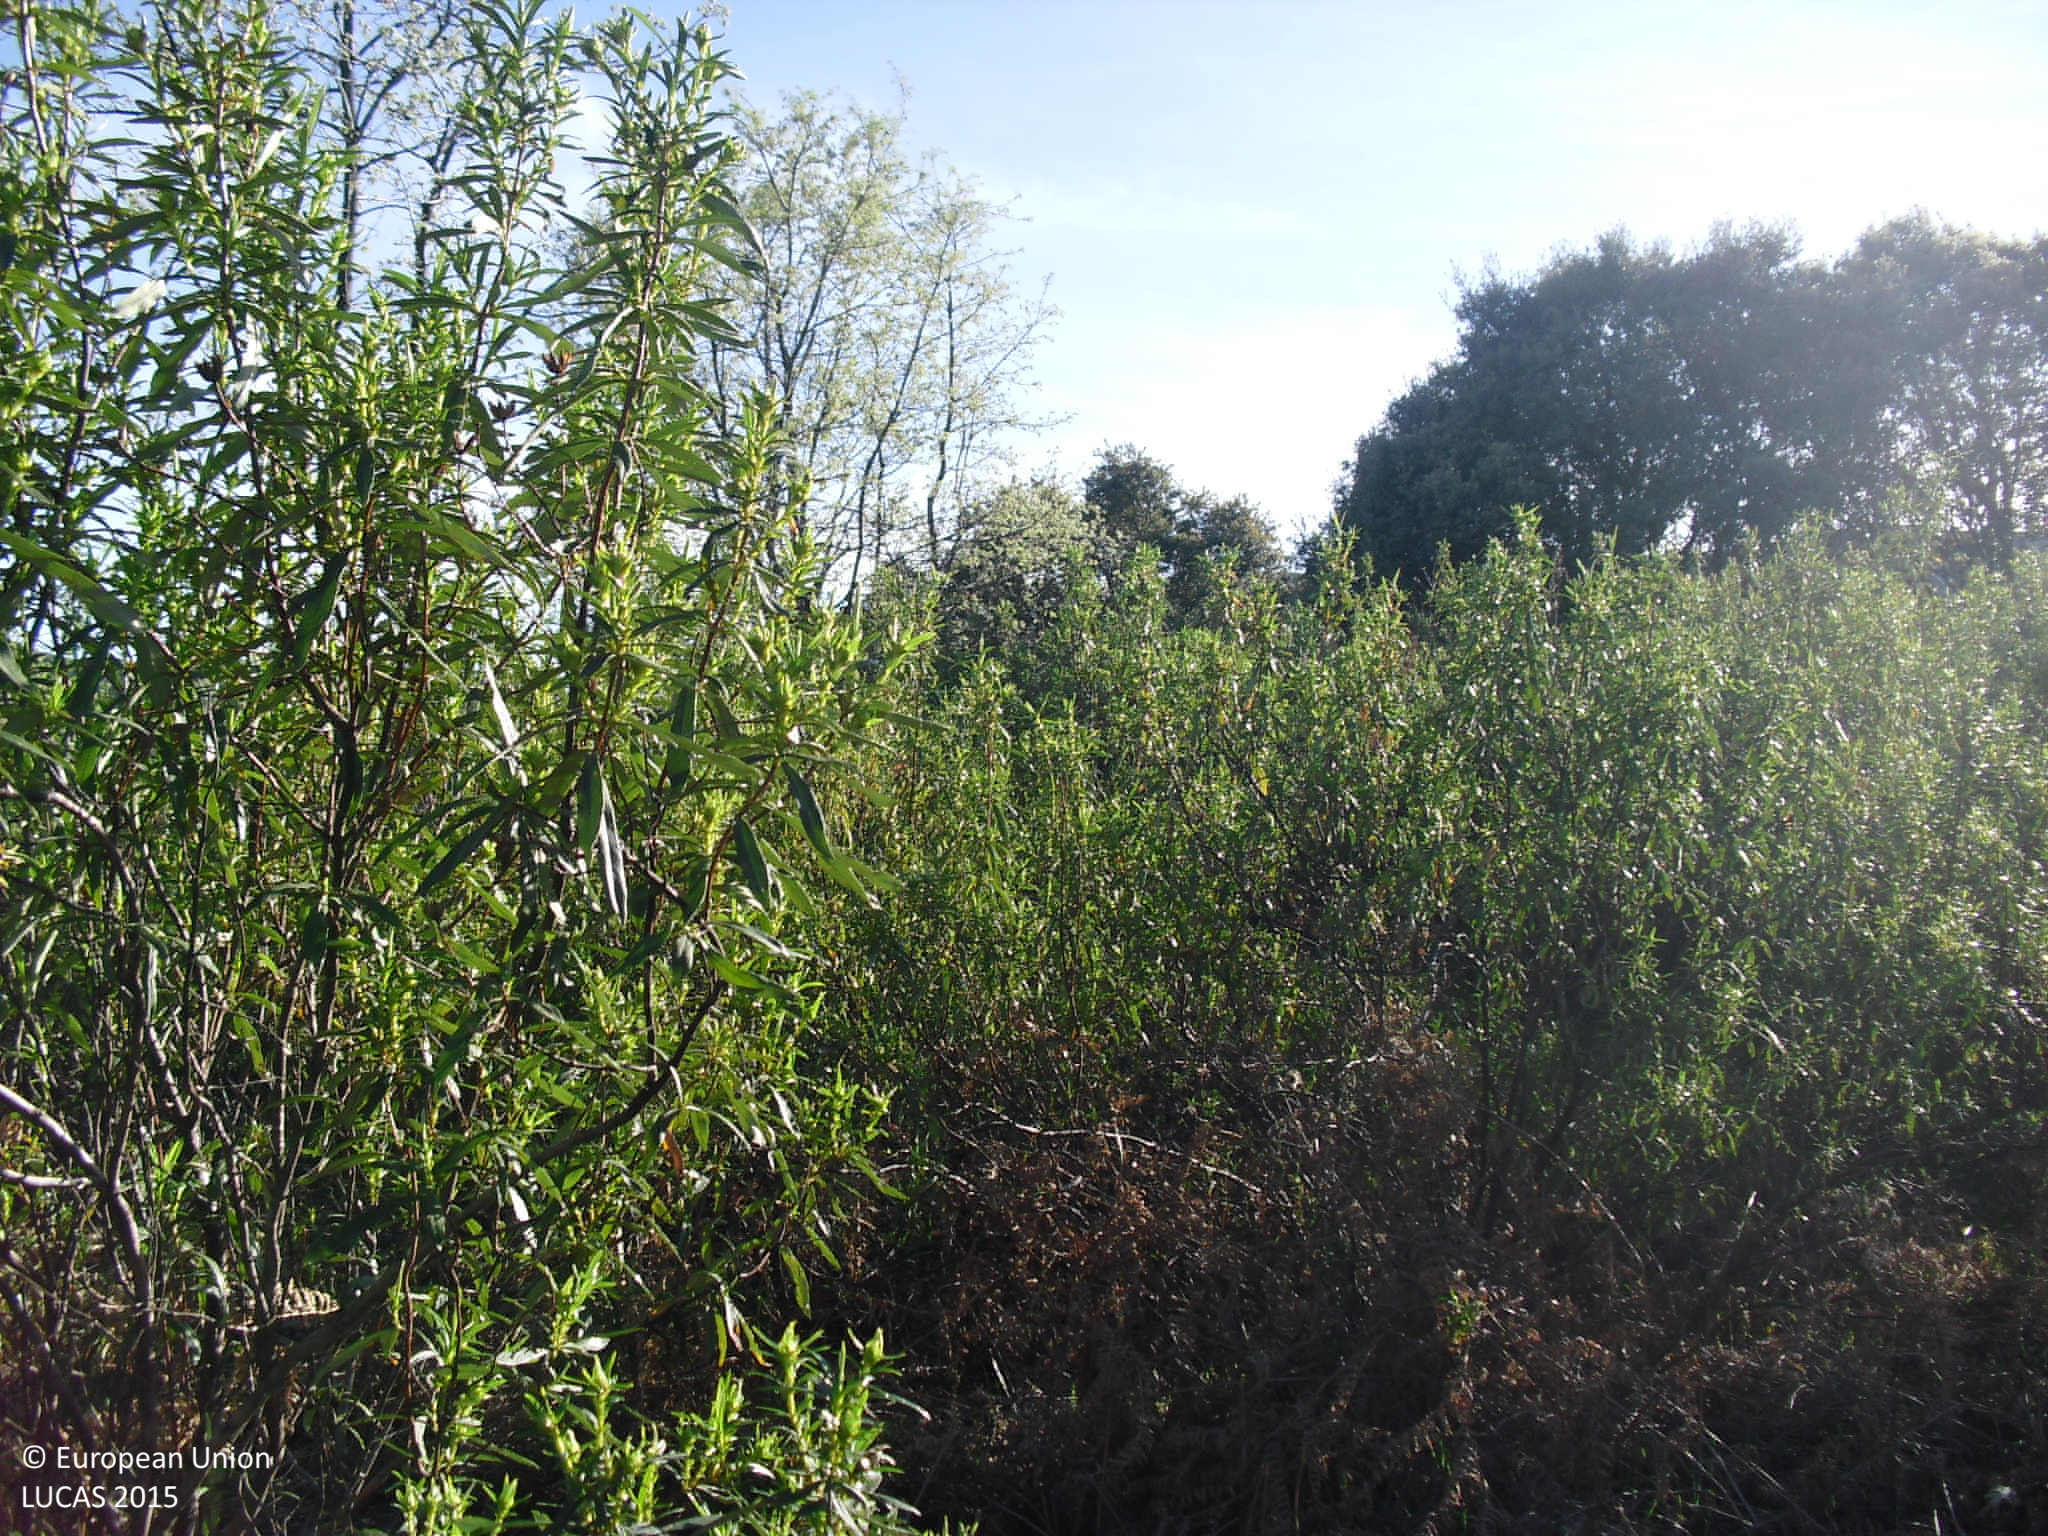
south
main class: Shrubland
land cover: Shrubland with sparse tree cover
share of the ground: 10 - 25 %
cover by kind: shrubs 85 %, herbaceous plants 10 %, broadleaved forest trees 5 %
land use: Semi-natural and natural areas not in use
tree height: > 5 m
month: April
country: ES
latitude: 39.4019
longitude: -5.3415
